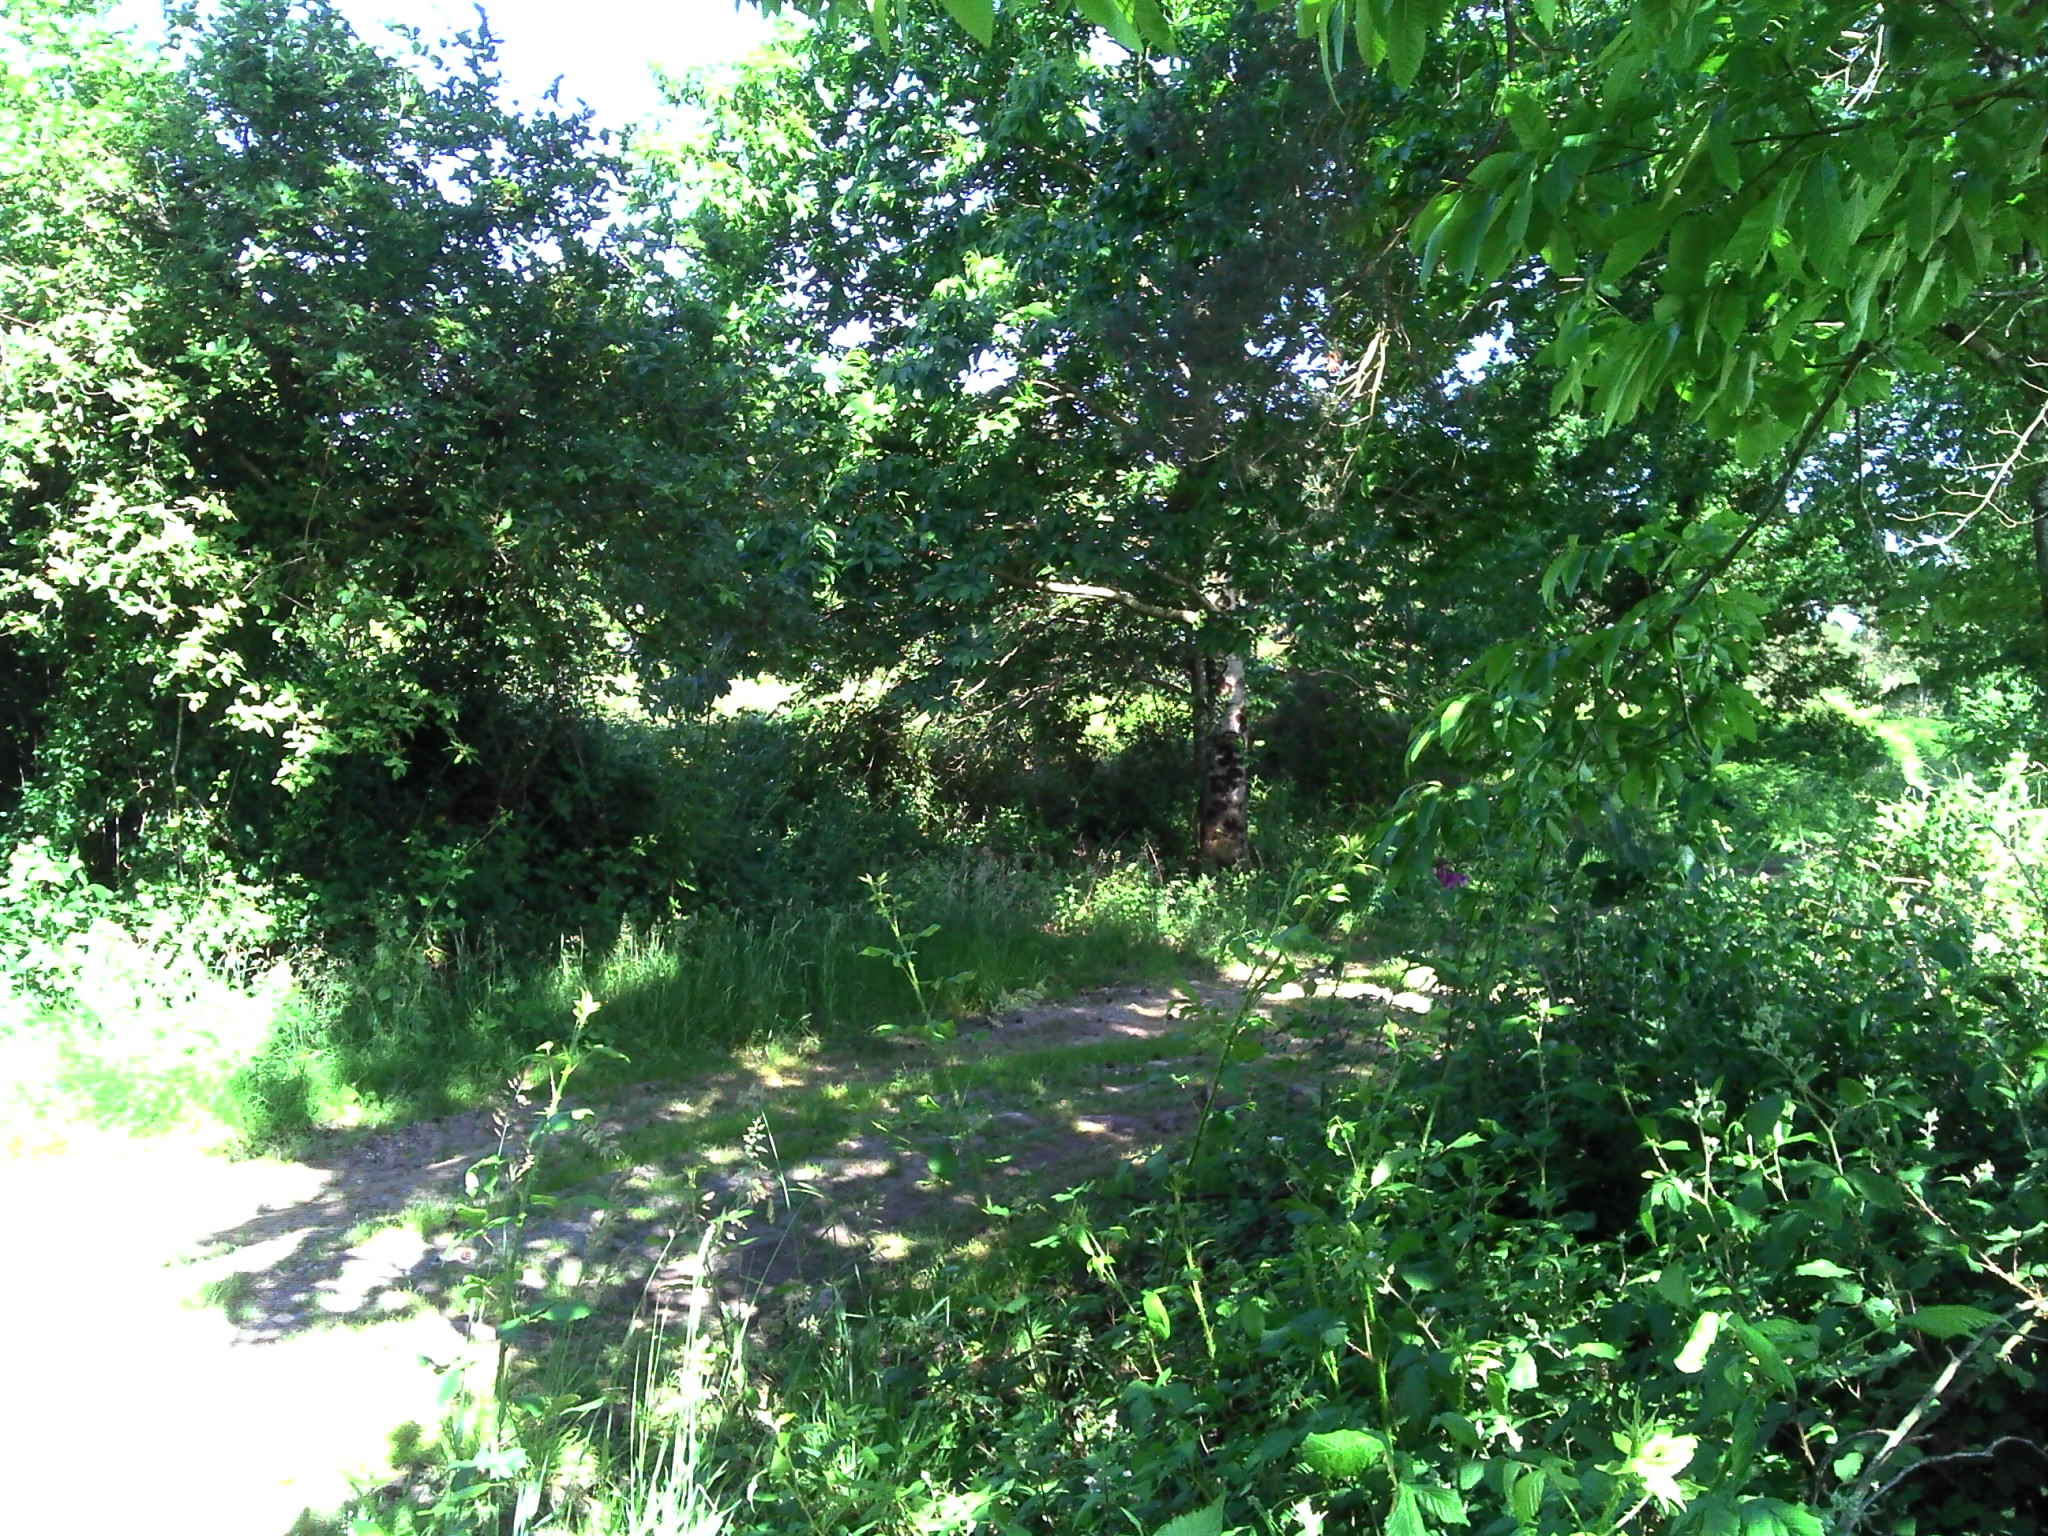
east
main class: Woodland
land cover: Broadleaved woodland
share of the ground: > 75 %
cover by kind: broadleaved forest trees 90 %, herbaceous plants 10 %
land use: Agriculture (excluding fallow land and kitchen gardens)
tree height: > 5 m
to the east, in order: Broadleaved woodland; Fences; Tracks; Broadleaved woodland; Spontaneously vegetated surfaces; Broadleaved woodland; Maize
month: June
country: FR
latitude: 48.2070
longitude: -1.4428
